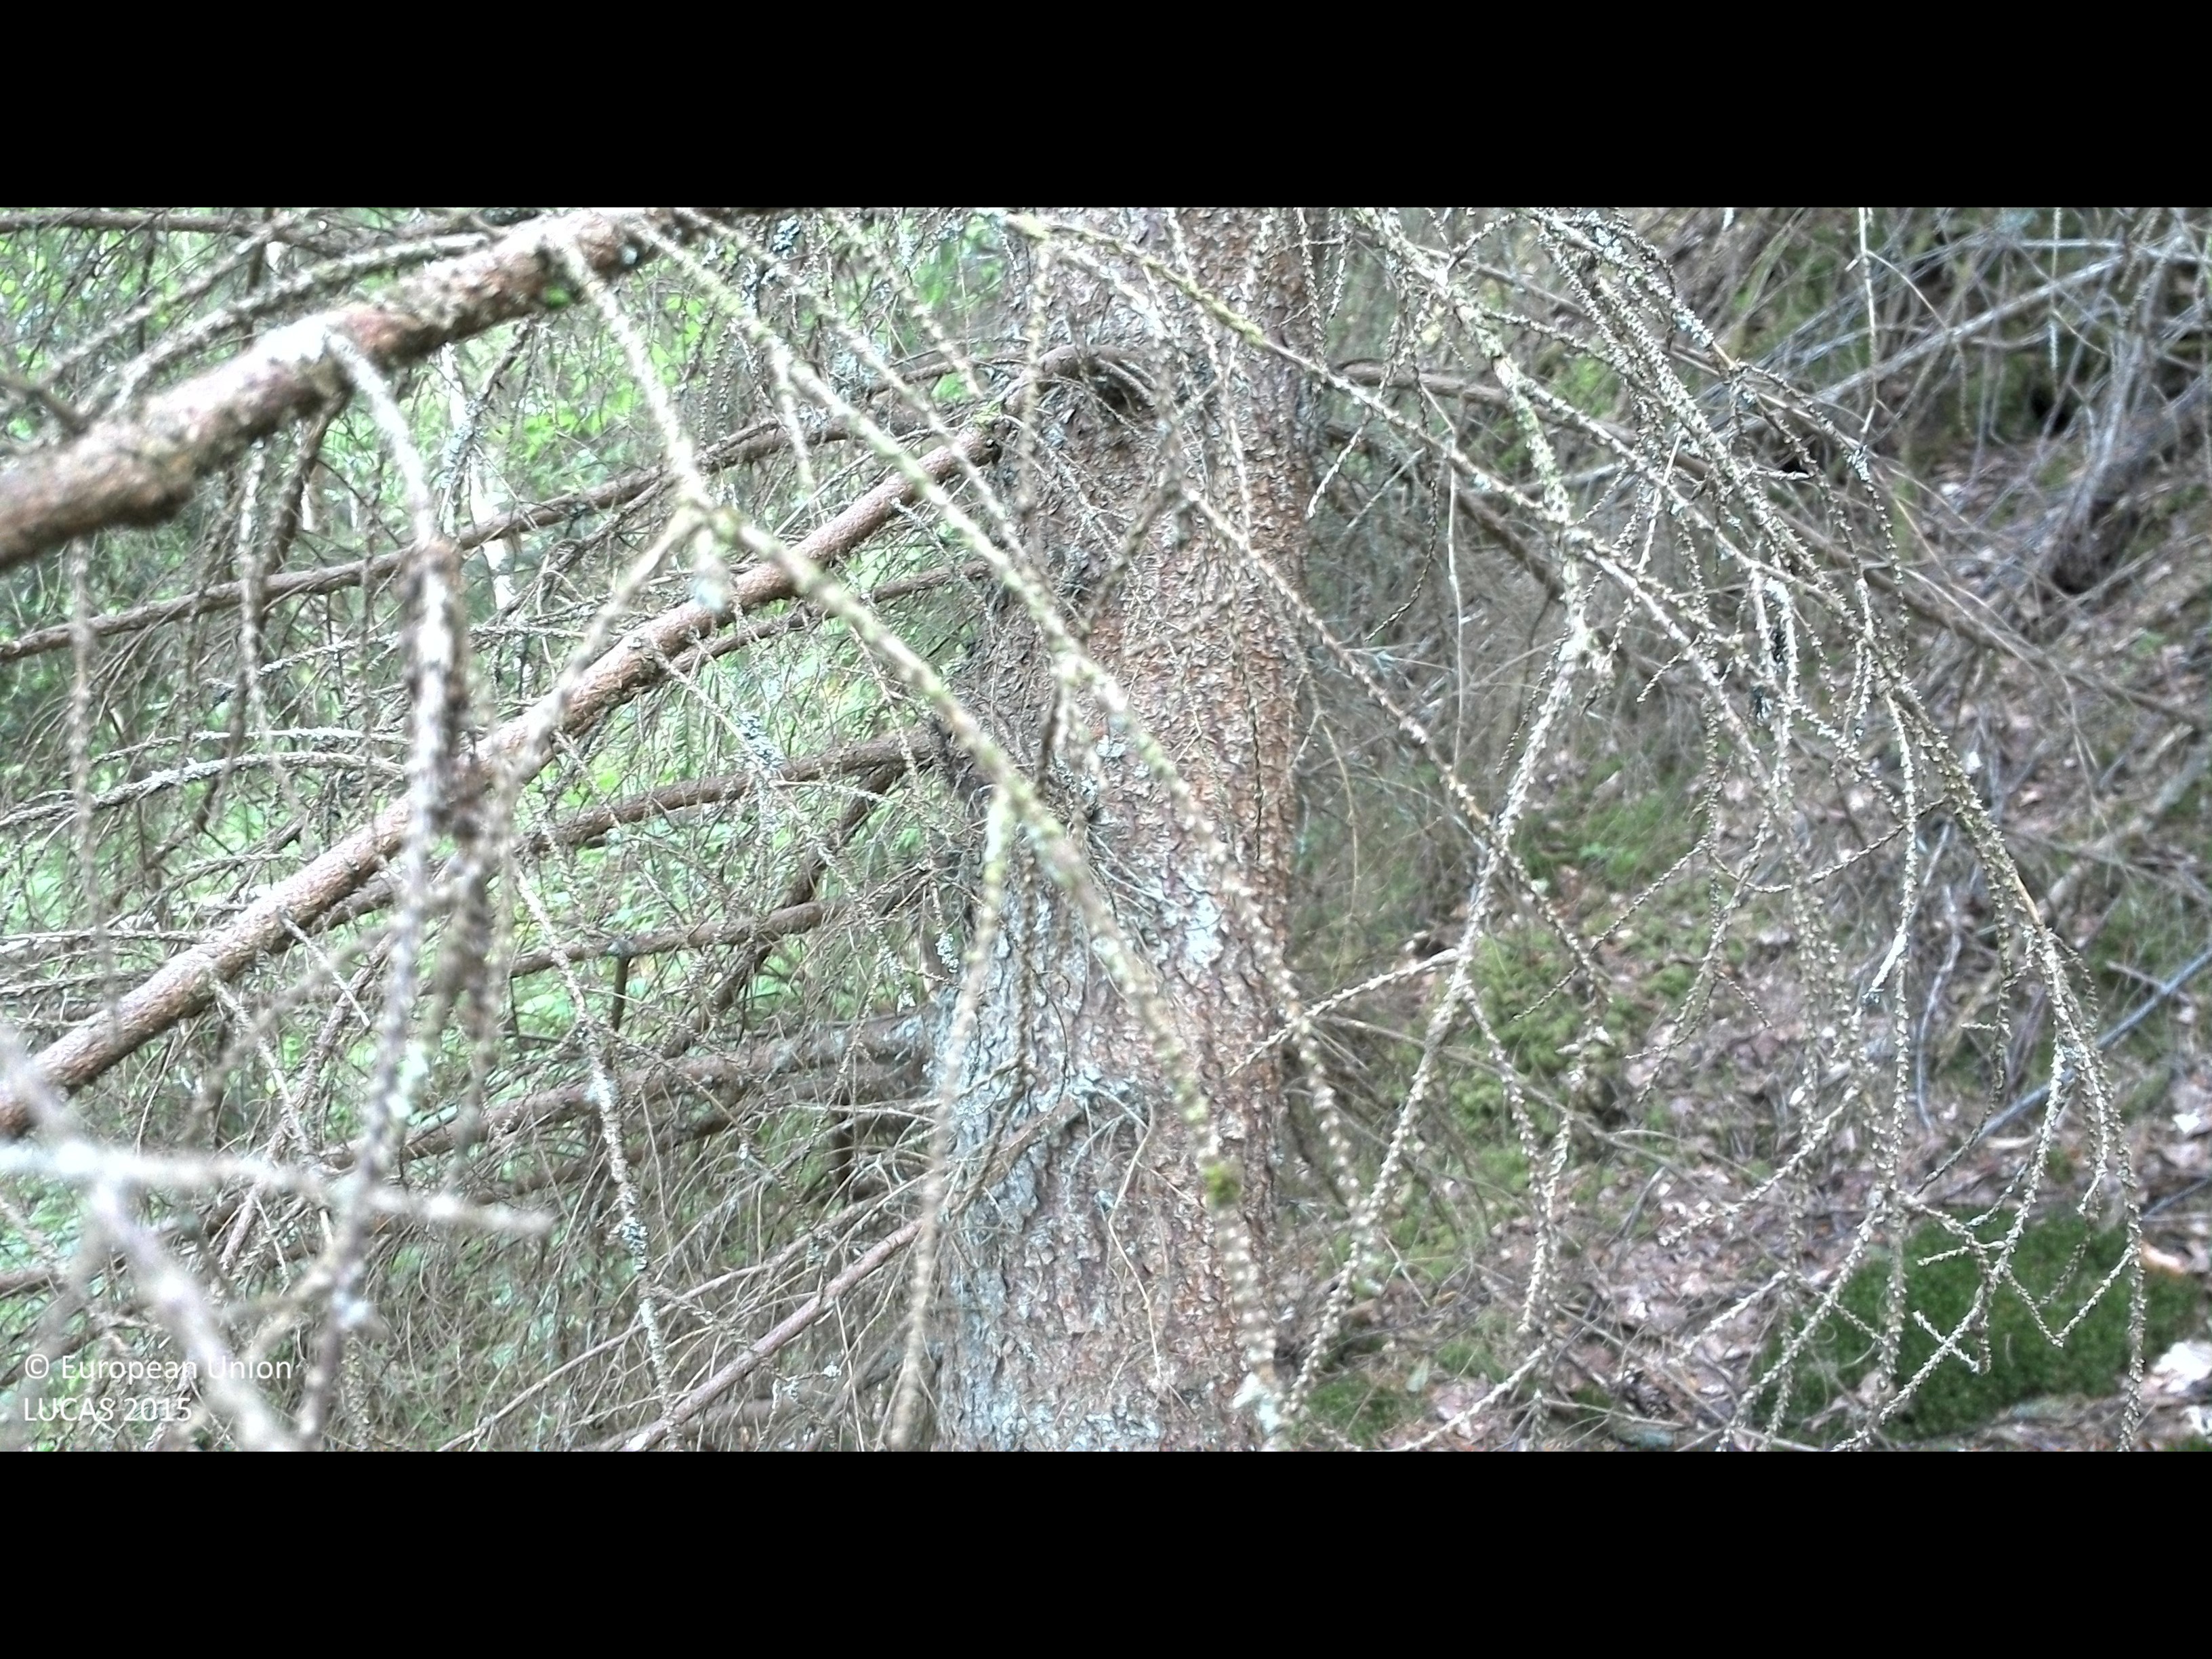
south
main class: Woodland
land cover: Spruce dominated coniferous woodland
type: boreal forest
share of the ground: > 75 %
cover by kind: coniferous forest trees 75 %, broadleaved forest trees 10 %, lichens and mosses 10 %, herbaceous plants 5 %
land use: Forestry
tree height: > 5 m
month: July
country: SE
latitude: 56.4144
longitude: 15.0068
